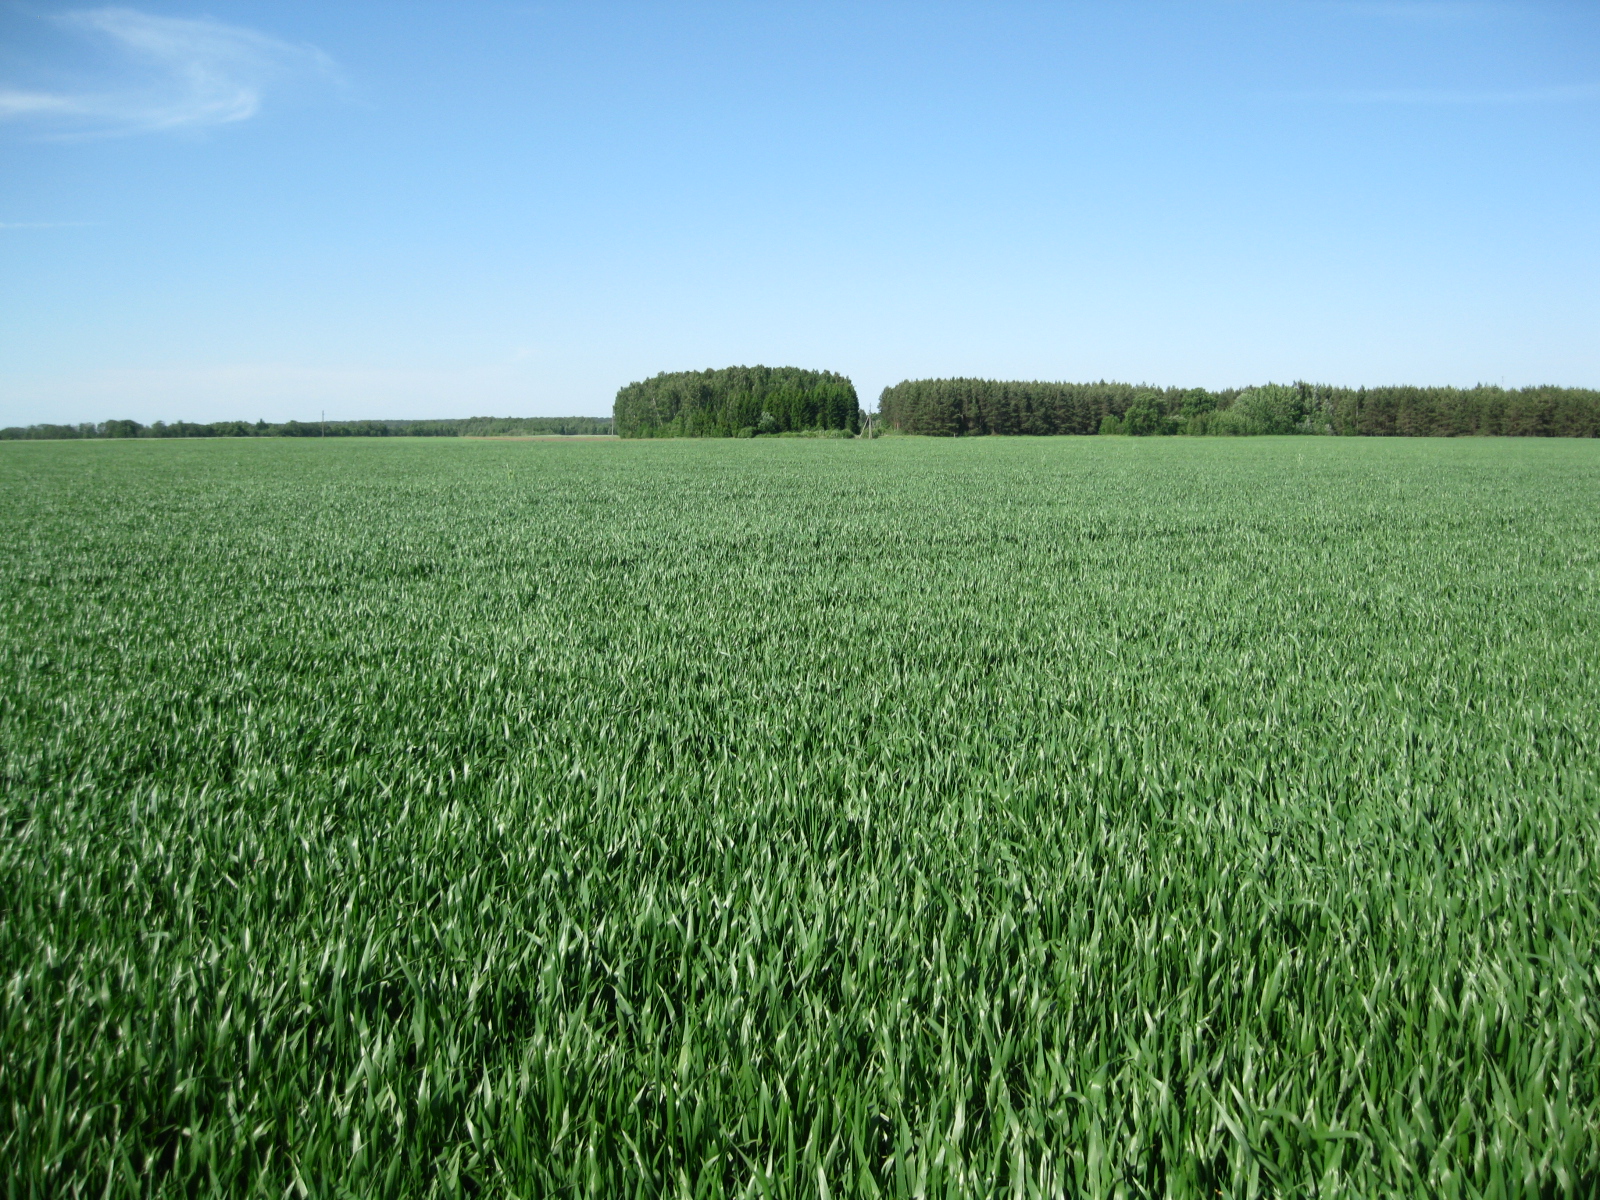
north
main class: Cropland
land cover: Common wheat
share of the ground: > 75 %
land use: Agriculture (excluding fallow land and kitchen gardens)
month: June
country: LT
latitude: 55.8674
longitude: 23.8760
